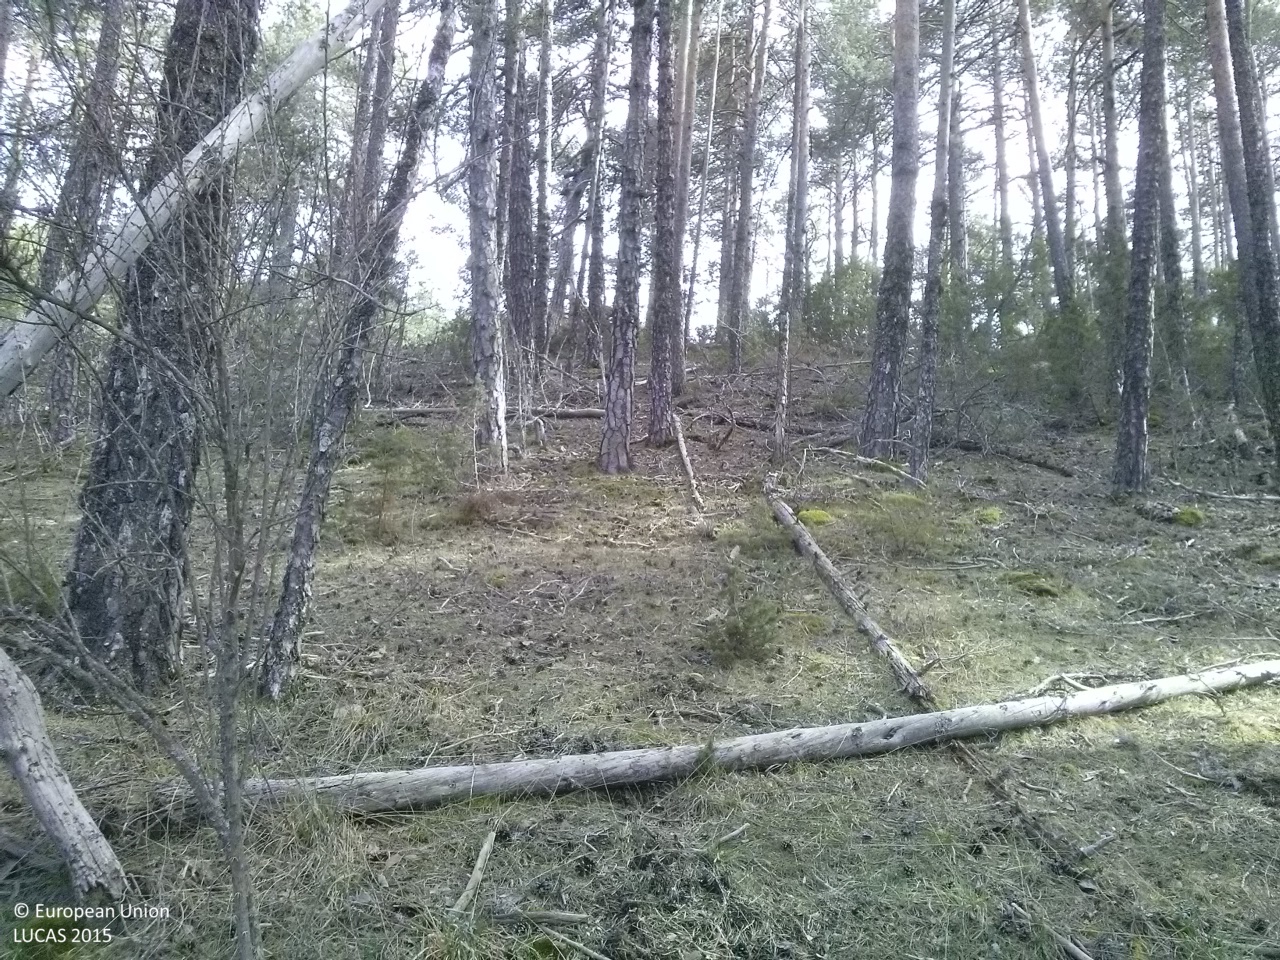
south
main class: Woodland
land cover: Pine dominated coniferous woodland
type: coniferous forest of the mediterranean region
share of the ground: > 75 %
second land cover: Grassland without tree/shrub cover
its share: 10 - 25 %
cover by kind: coniferous forest trees 90 %, herbaceous plants 10 %
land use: Forestry
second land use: Agriculture (excluding fallow land and kitchen gardens)
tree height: > 5 m
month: April
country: ES
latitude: 40.2938
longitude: -1.8621
